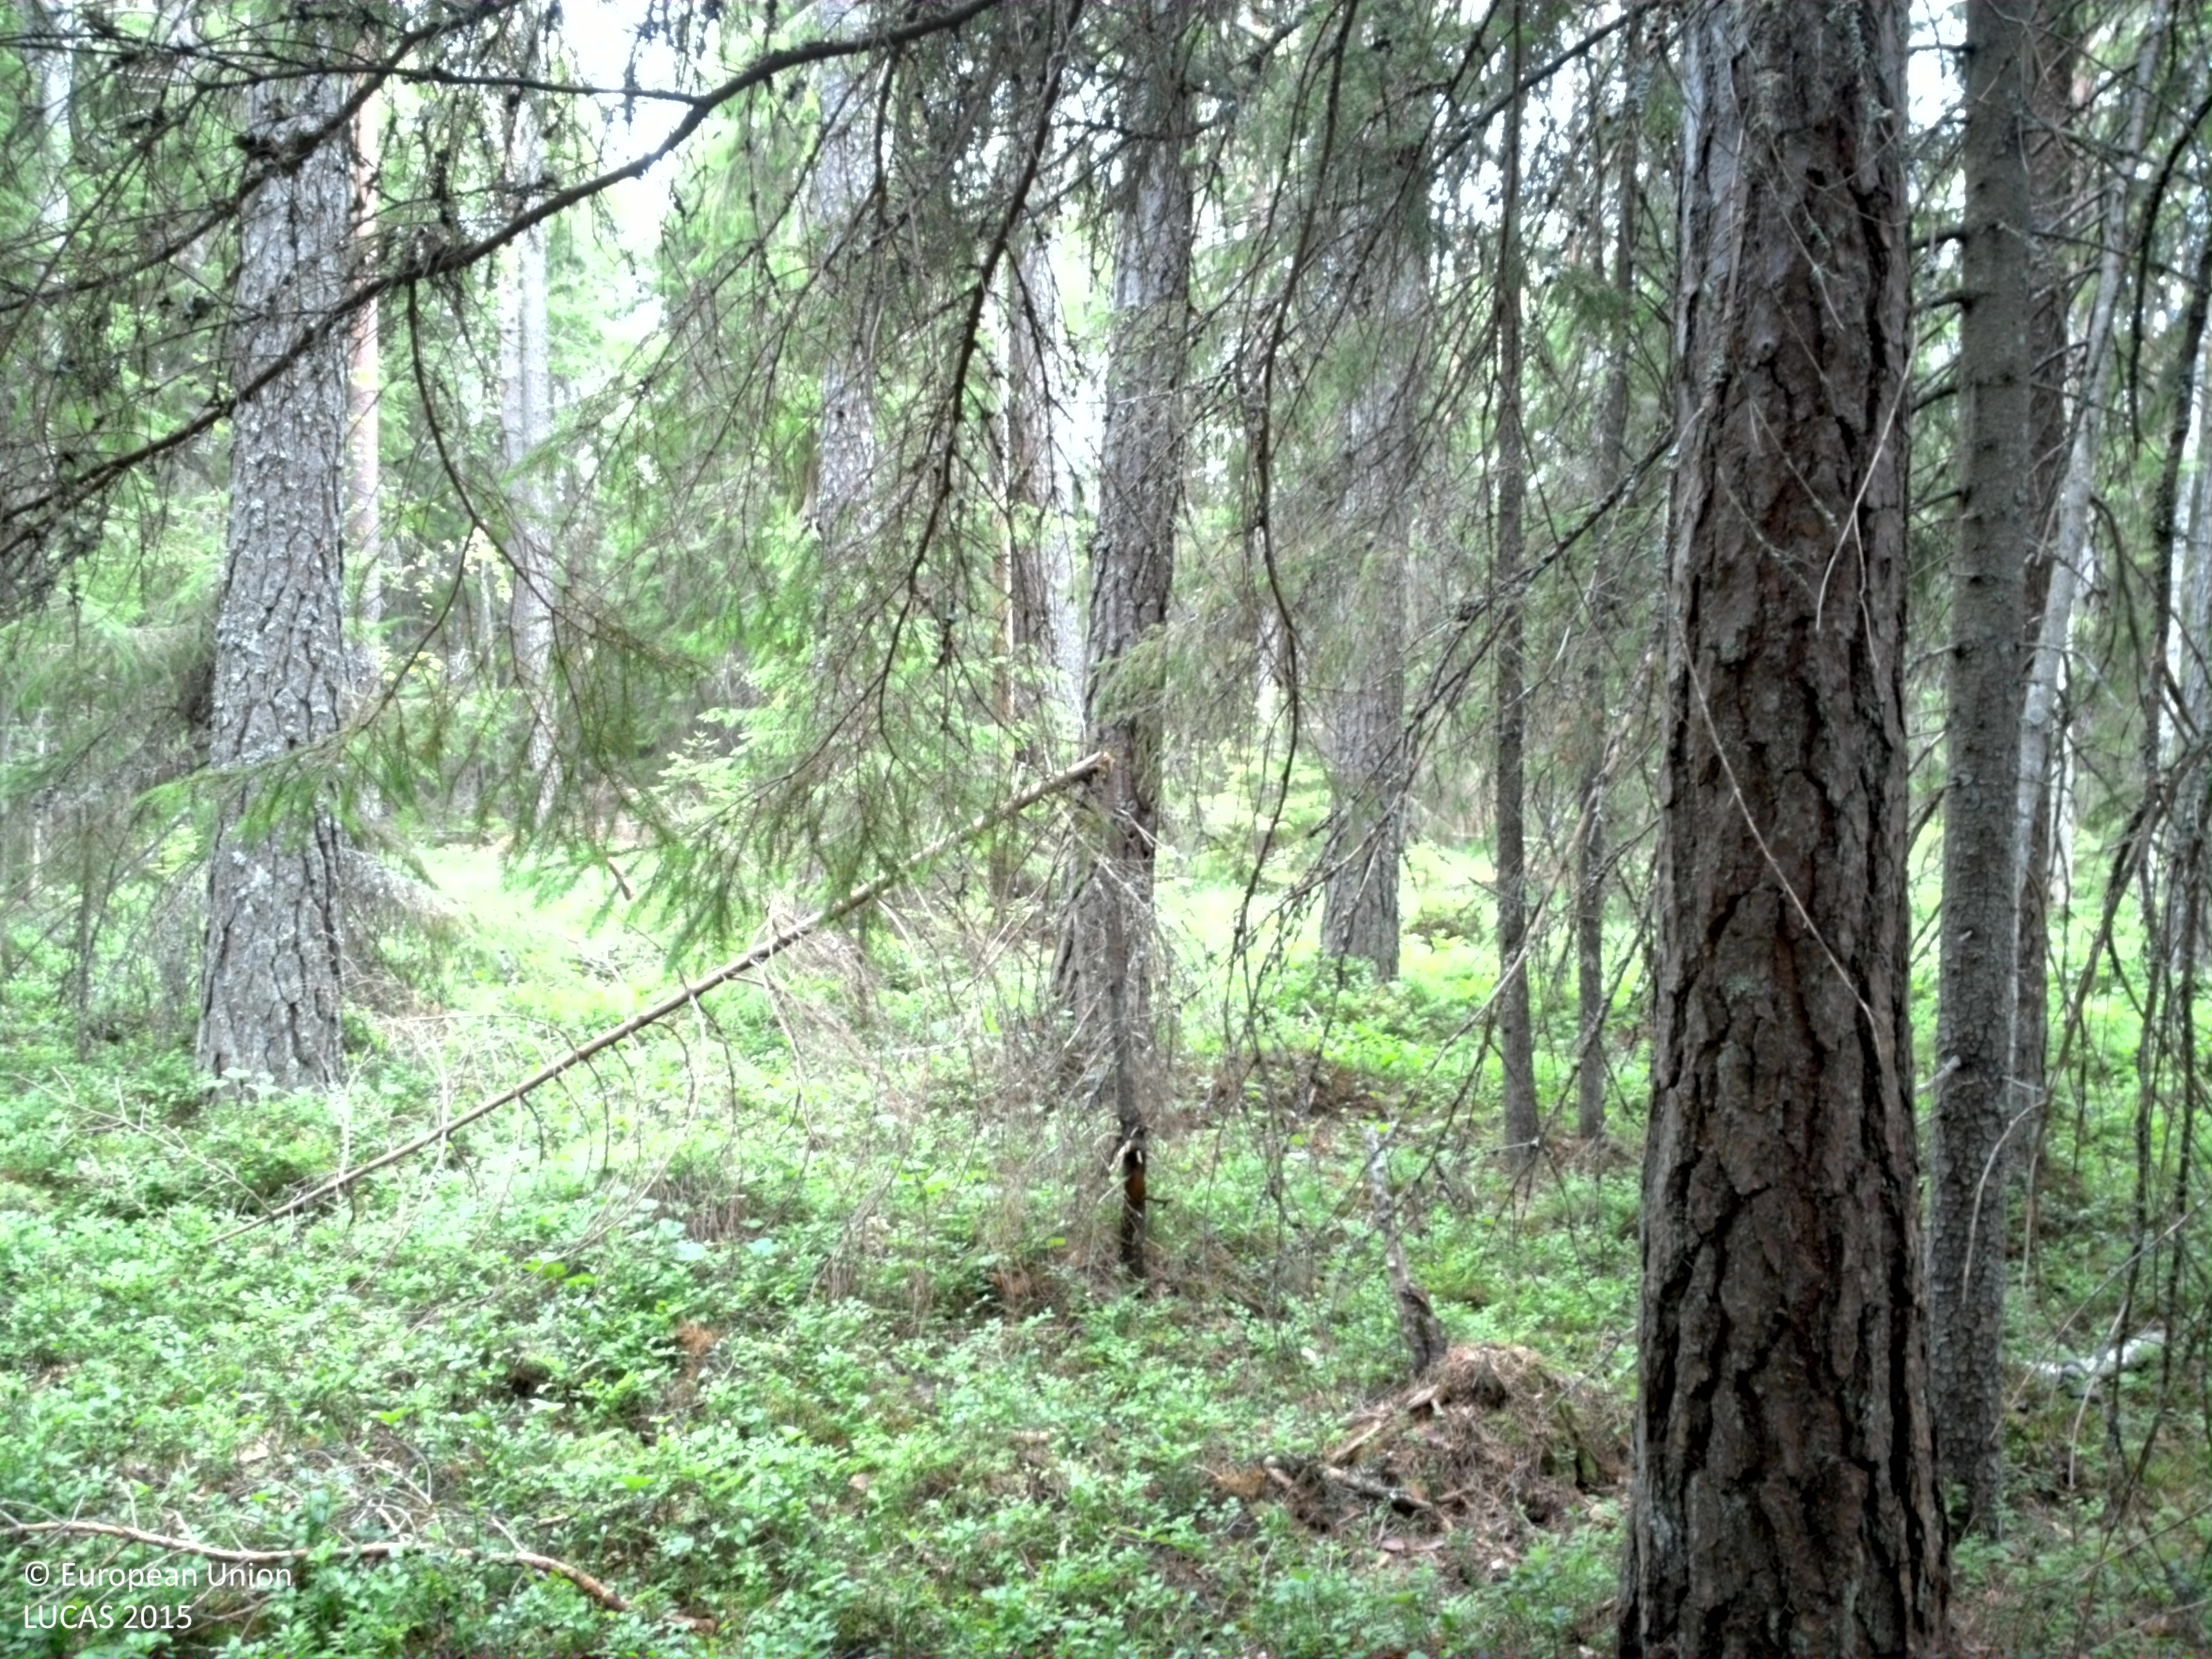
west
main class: Woodland
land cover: Spruce dominated coniferous woodland
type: boreal forest
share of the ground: 50 - 75 %
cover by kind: coniferous forest trees 75 %, lichens and mosses 15 %, herbaceous plants 10 %
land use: Forestry
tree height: > 5 m
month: July
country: SE
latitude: 60.0556
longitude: 18.4203
